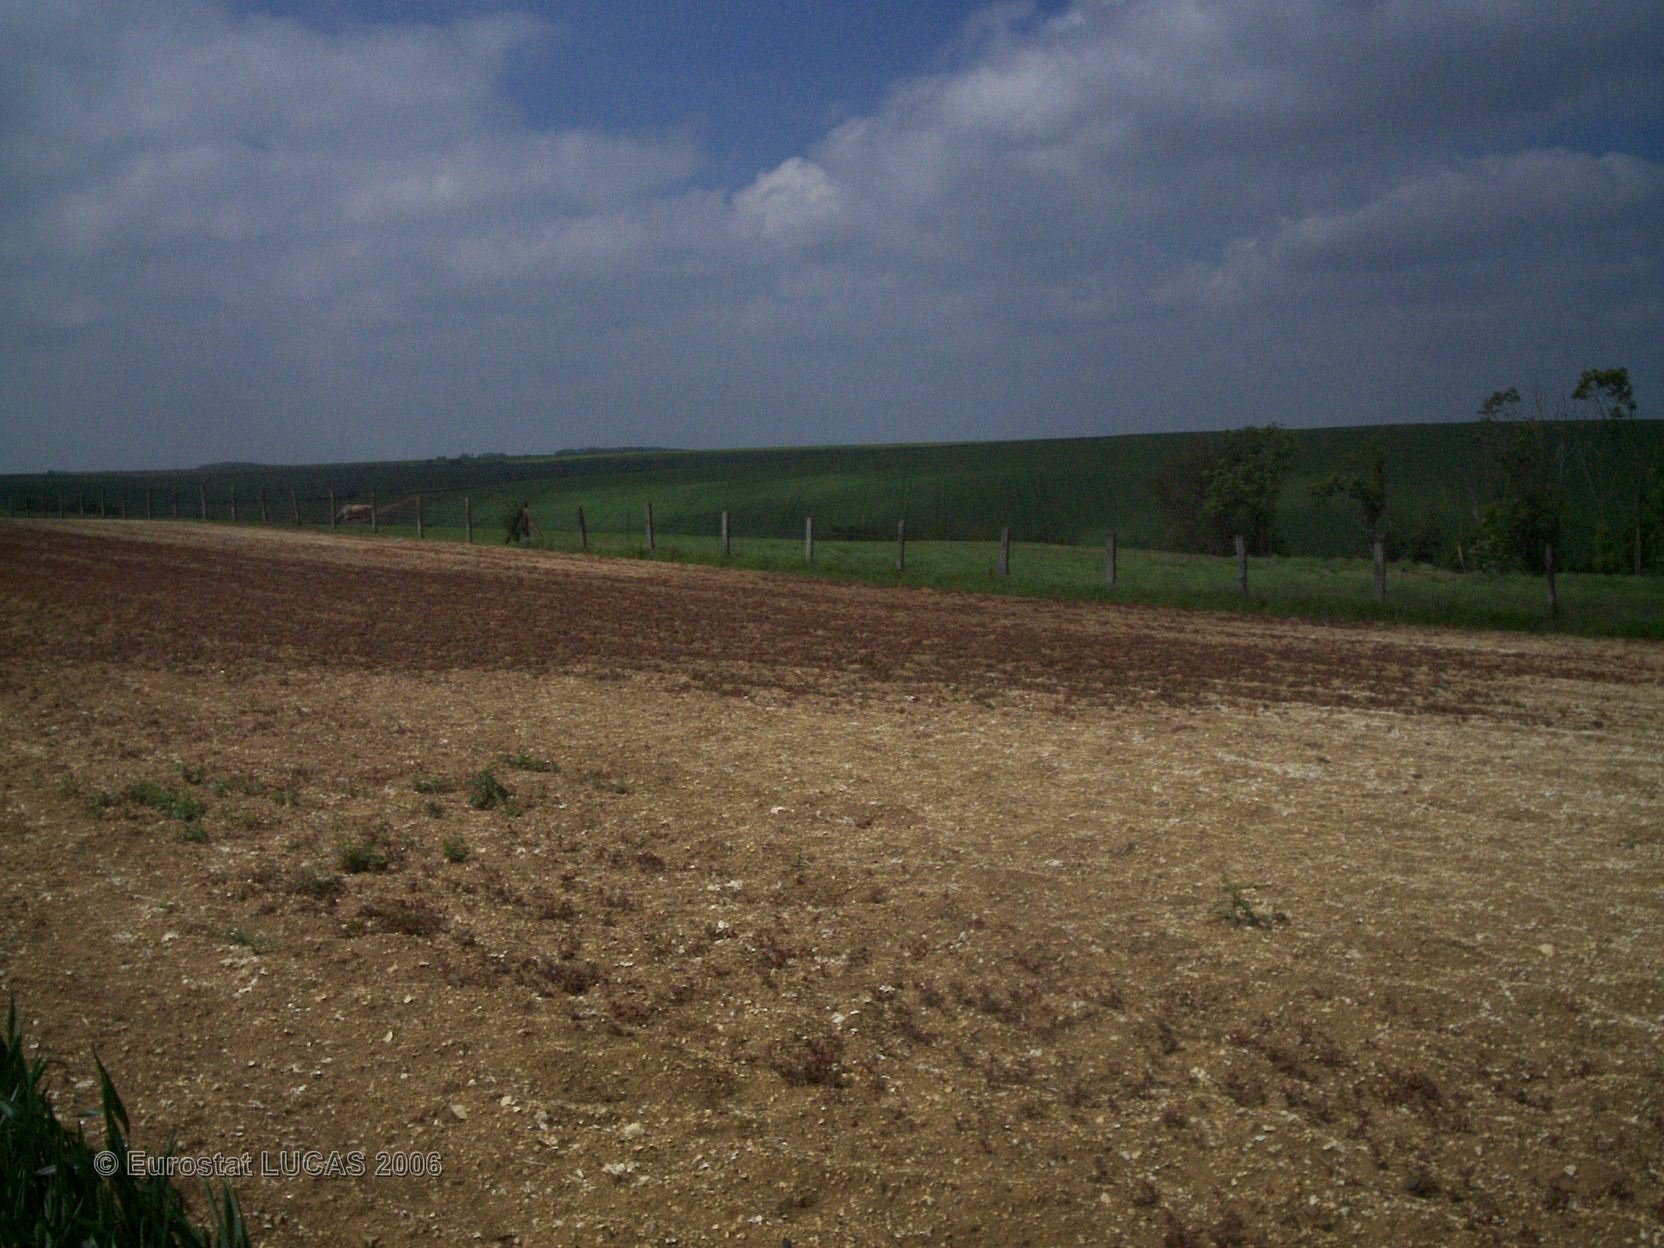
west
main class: Cropland
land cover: Common wheat
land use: Agriculture (excluding fallow land and kitchen gardens)
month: June
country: FR
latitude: 49.8965
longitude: 2.7080
